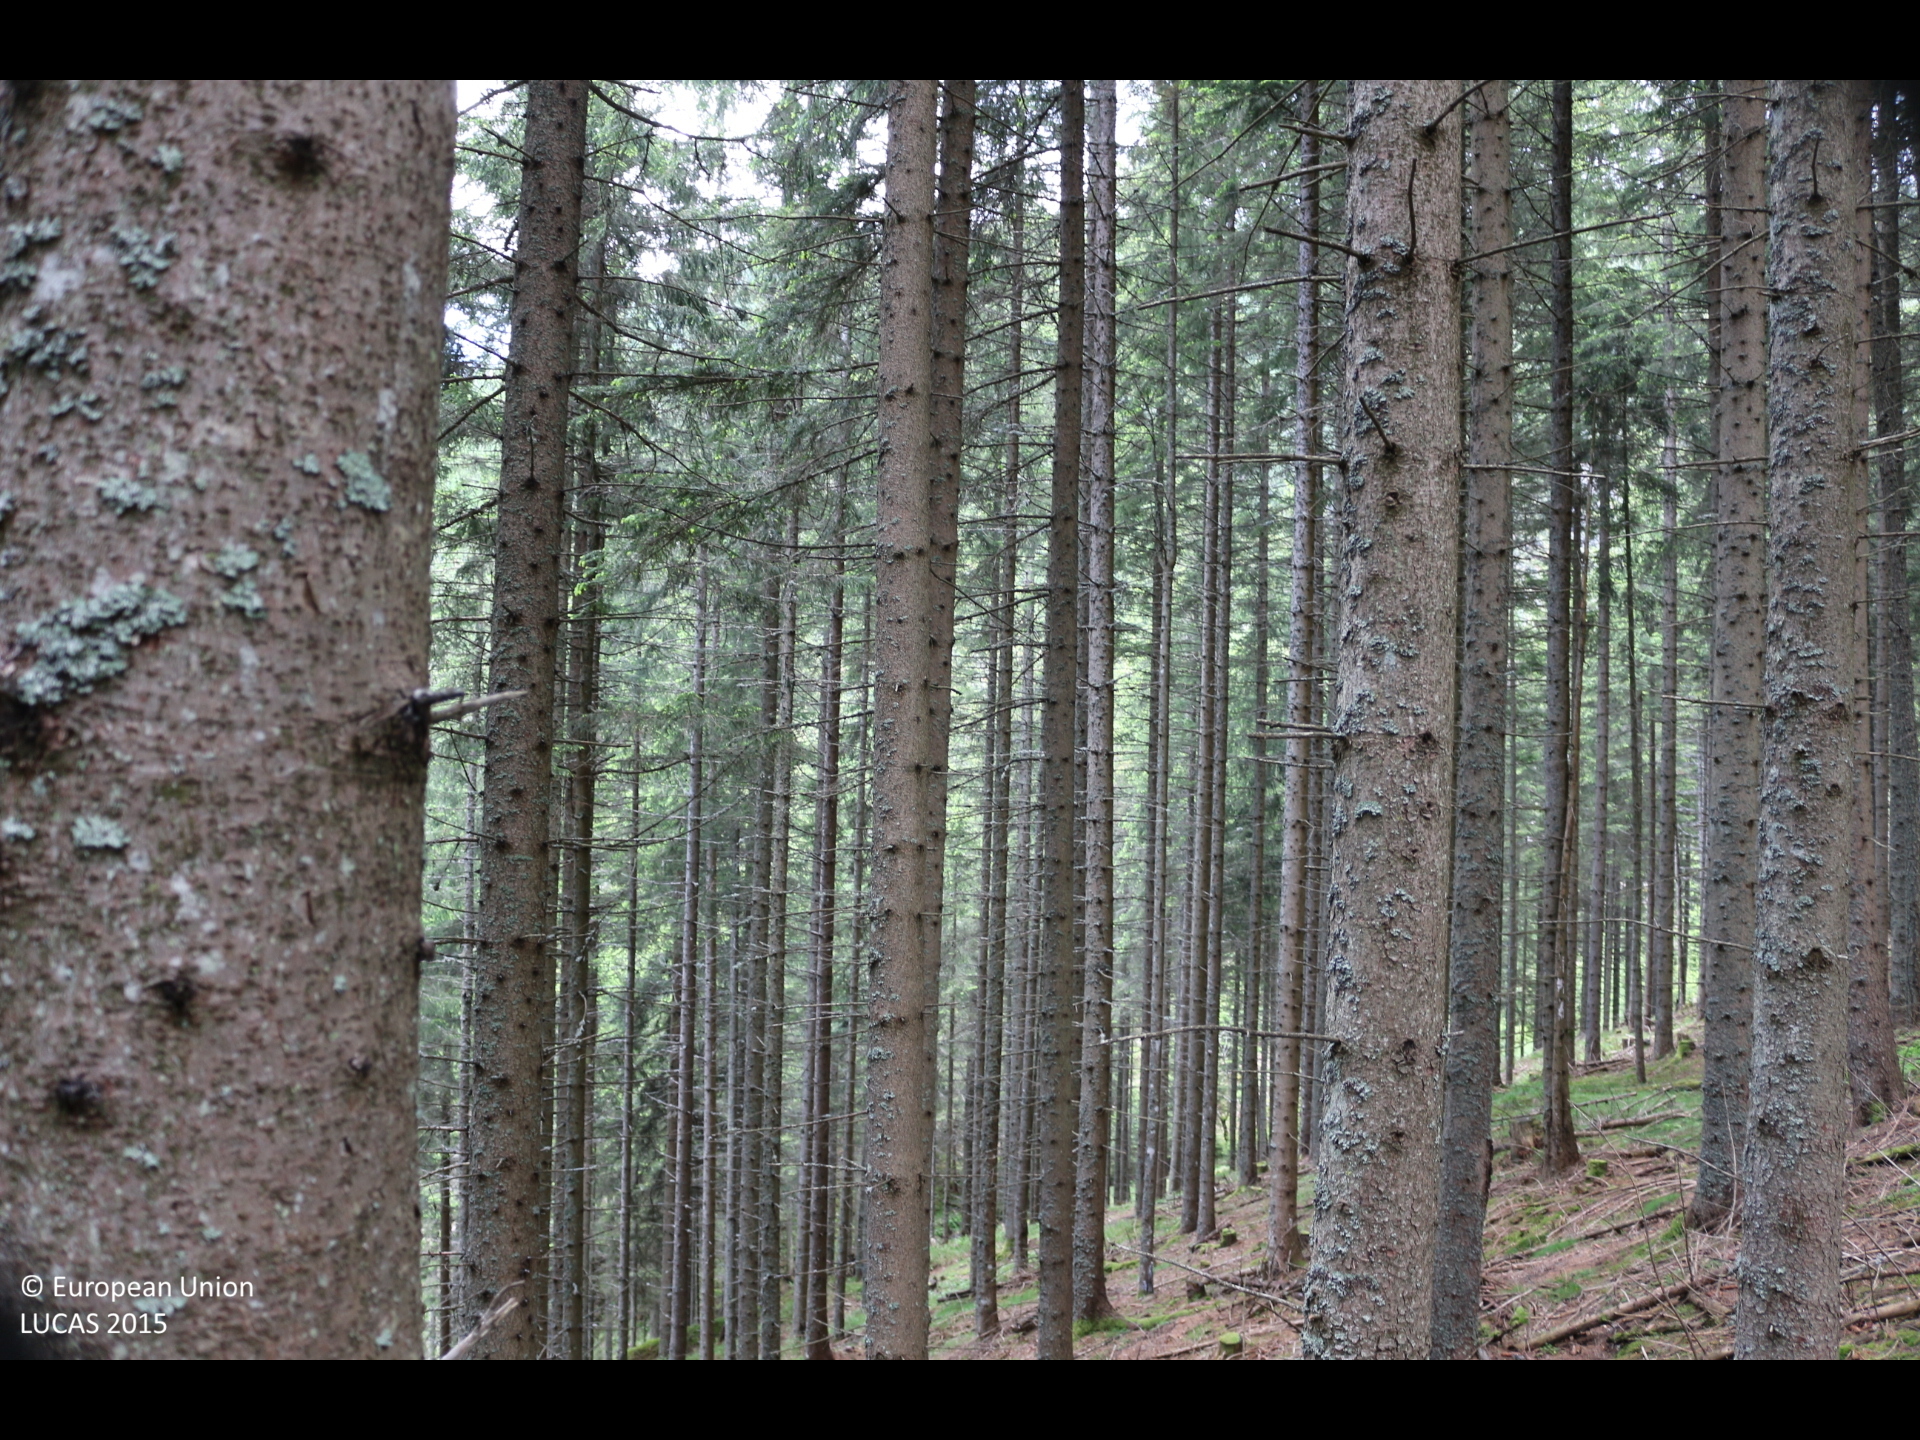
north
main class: Woodland
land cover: Spruce dominated coniferous woodland
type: alpine coniferous forest
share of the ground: > 75 %
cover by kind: coniferous forest trees 100 %
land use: Forestry
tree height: > 5 m
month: June
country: AT
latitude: 46.8295
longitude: 14.5996
